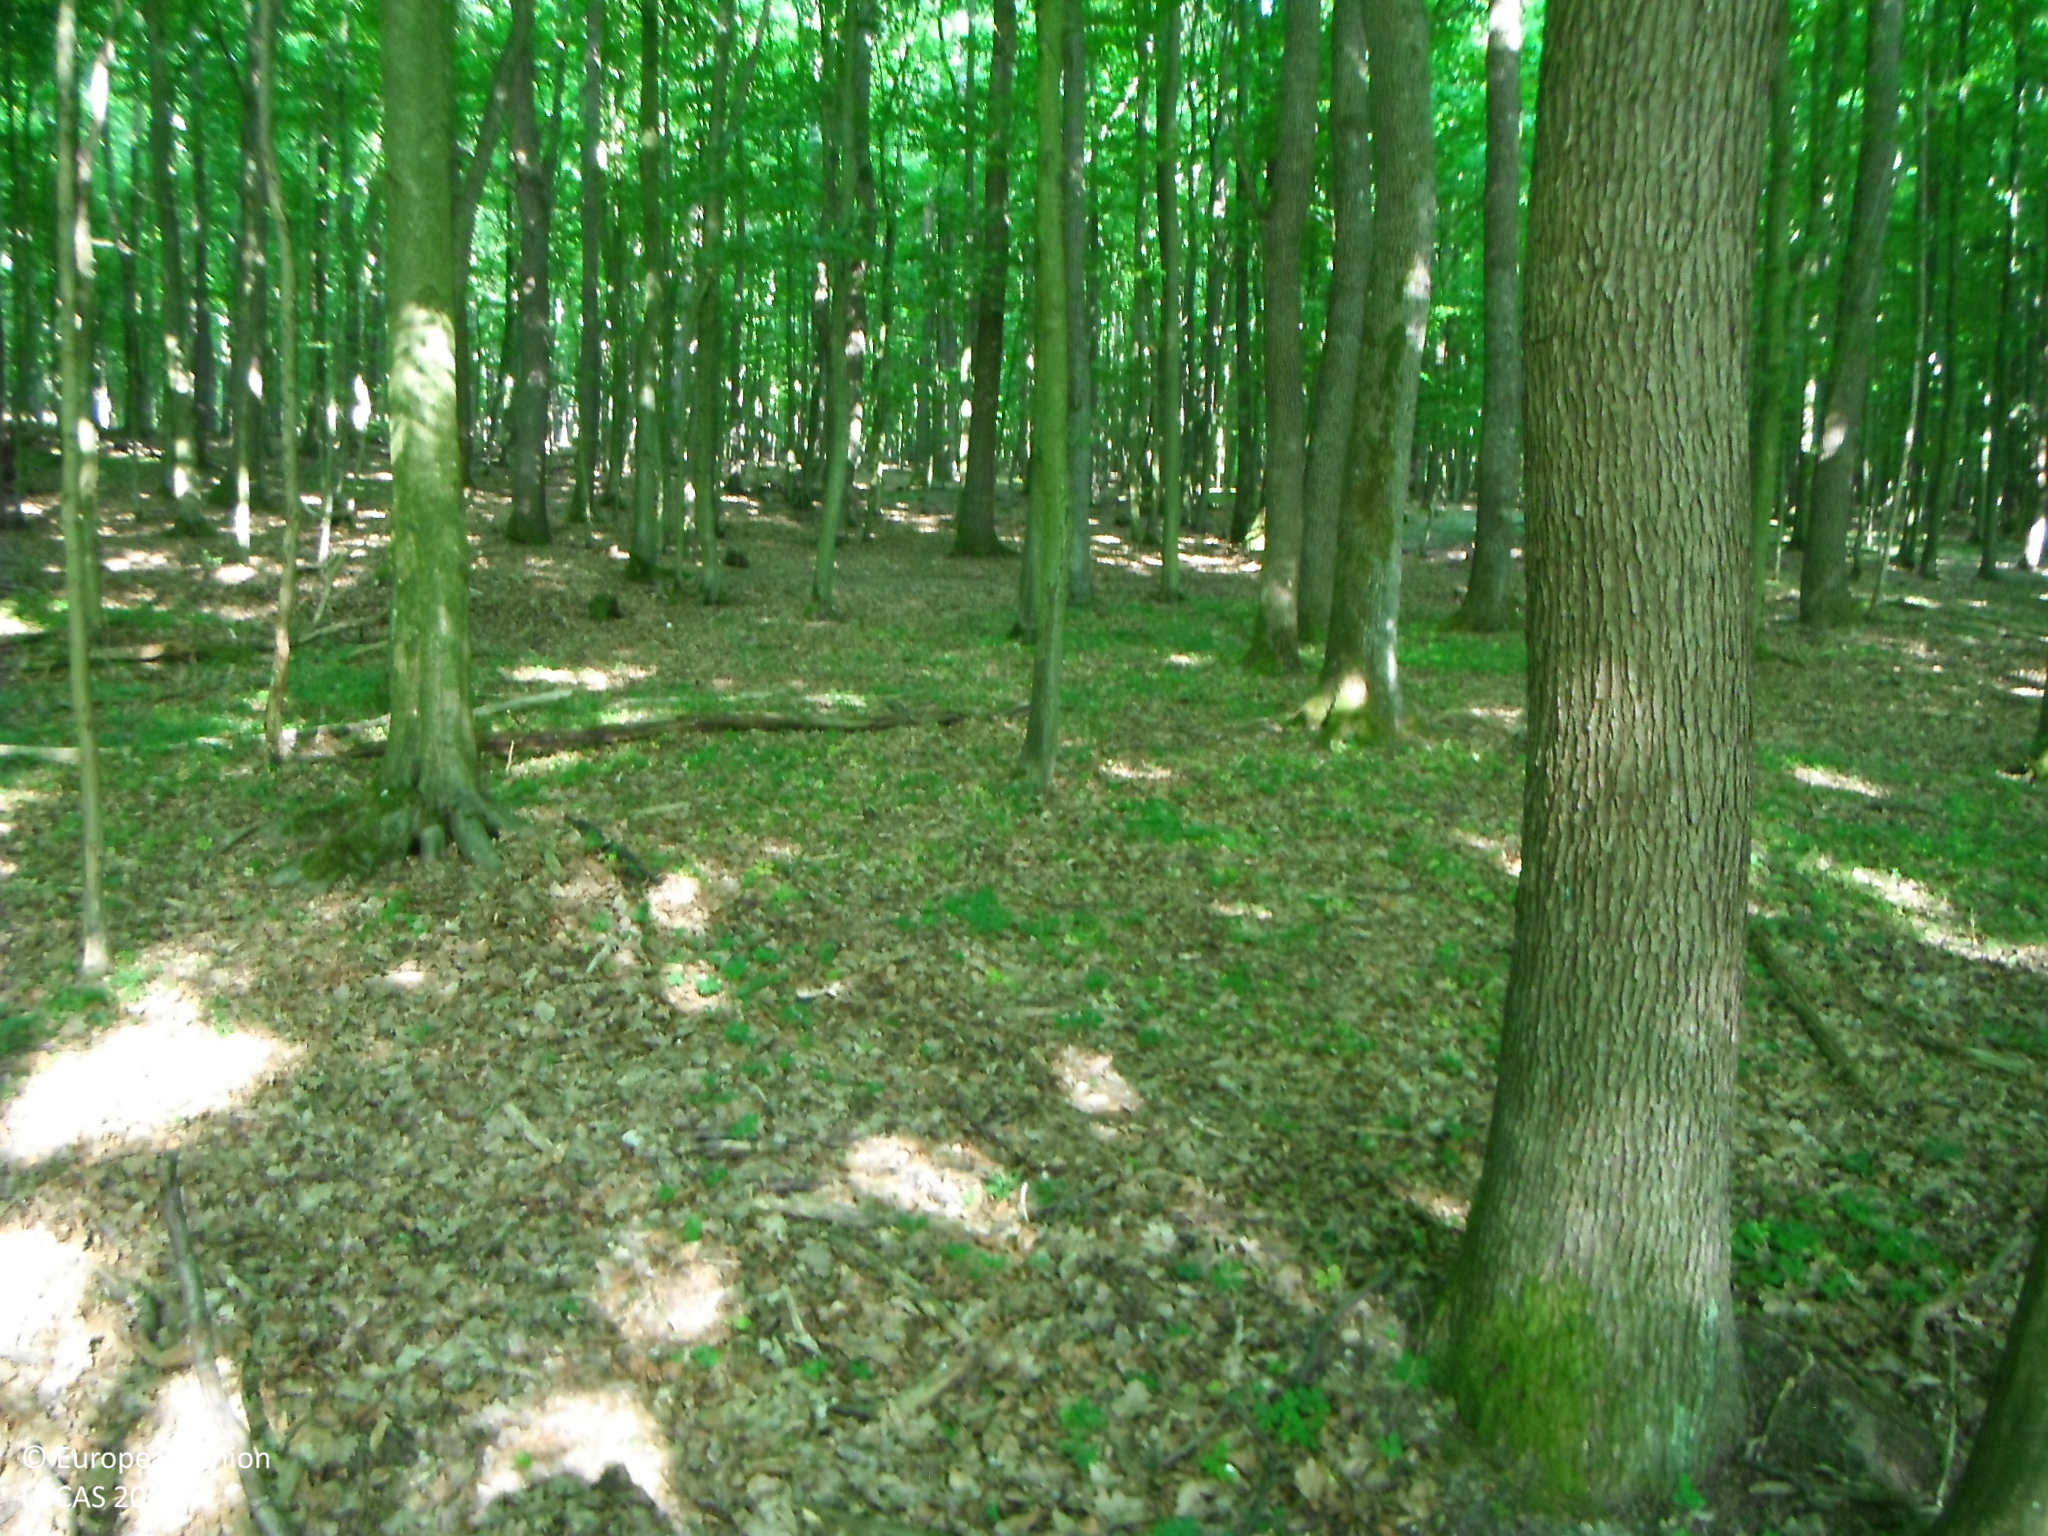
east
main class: Woodland
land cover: Broadleaved woodland
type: beech forest
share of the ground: > 75 %
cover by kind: broadleaved forest trees 100 %
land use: Forestry
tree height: > 5 m
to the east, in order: Broadleaved woodland
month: May
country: SK
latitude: 48.6851
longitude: 21.0304
